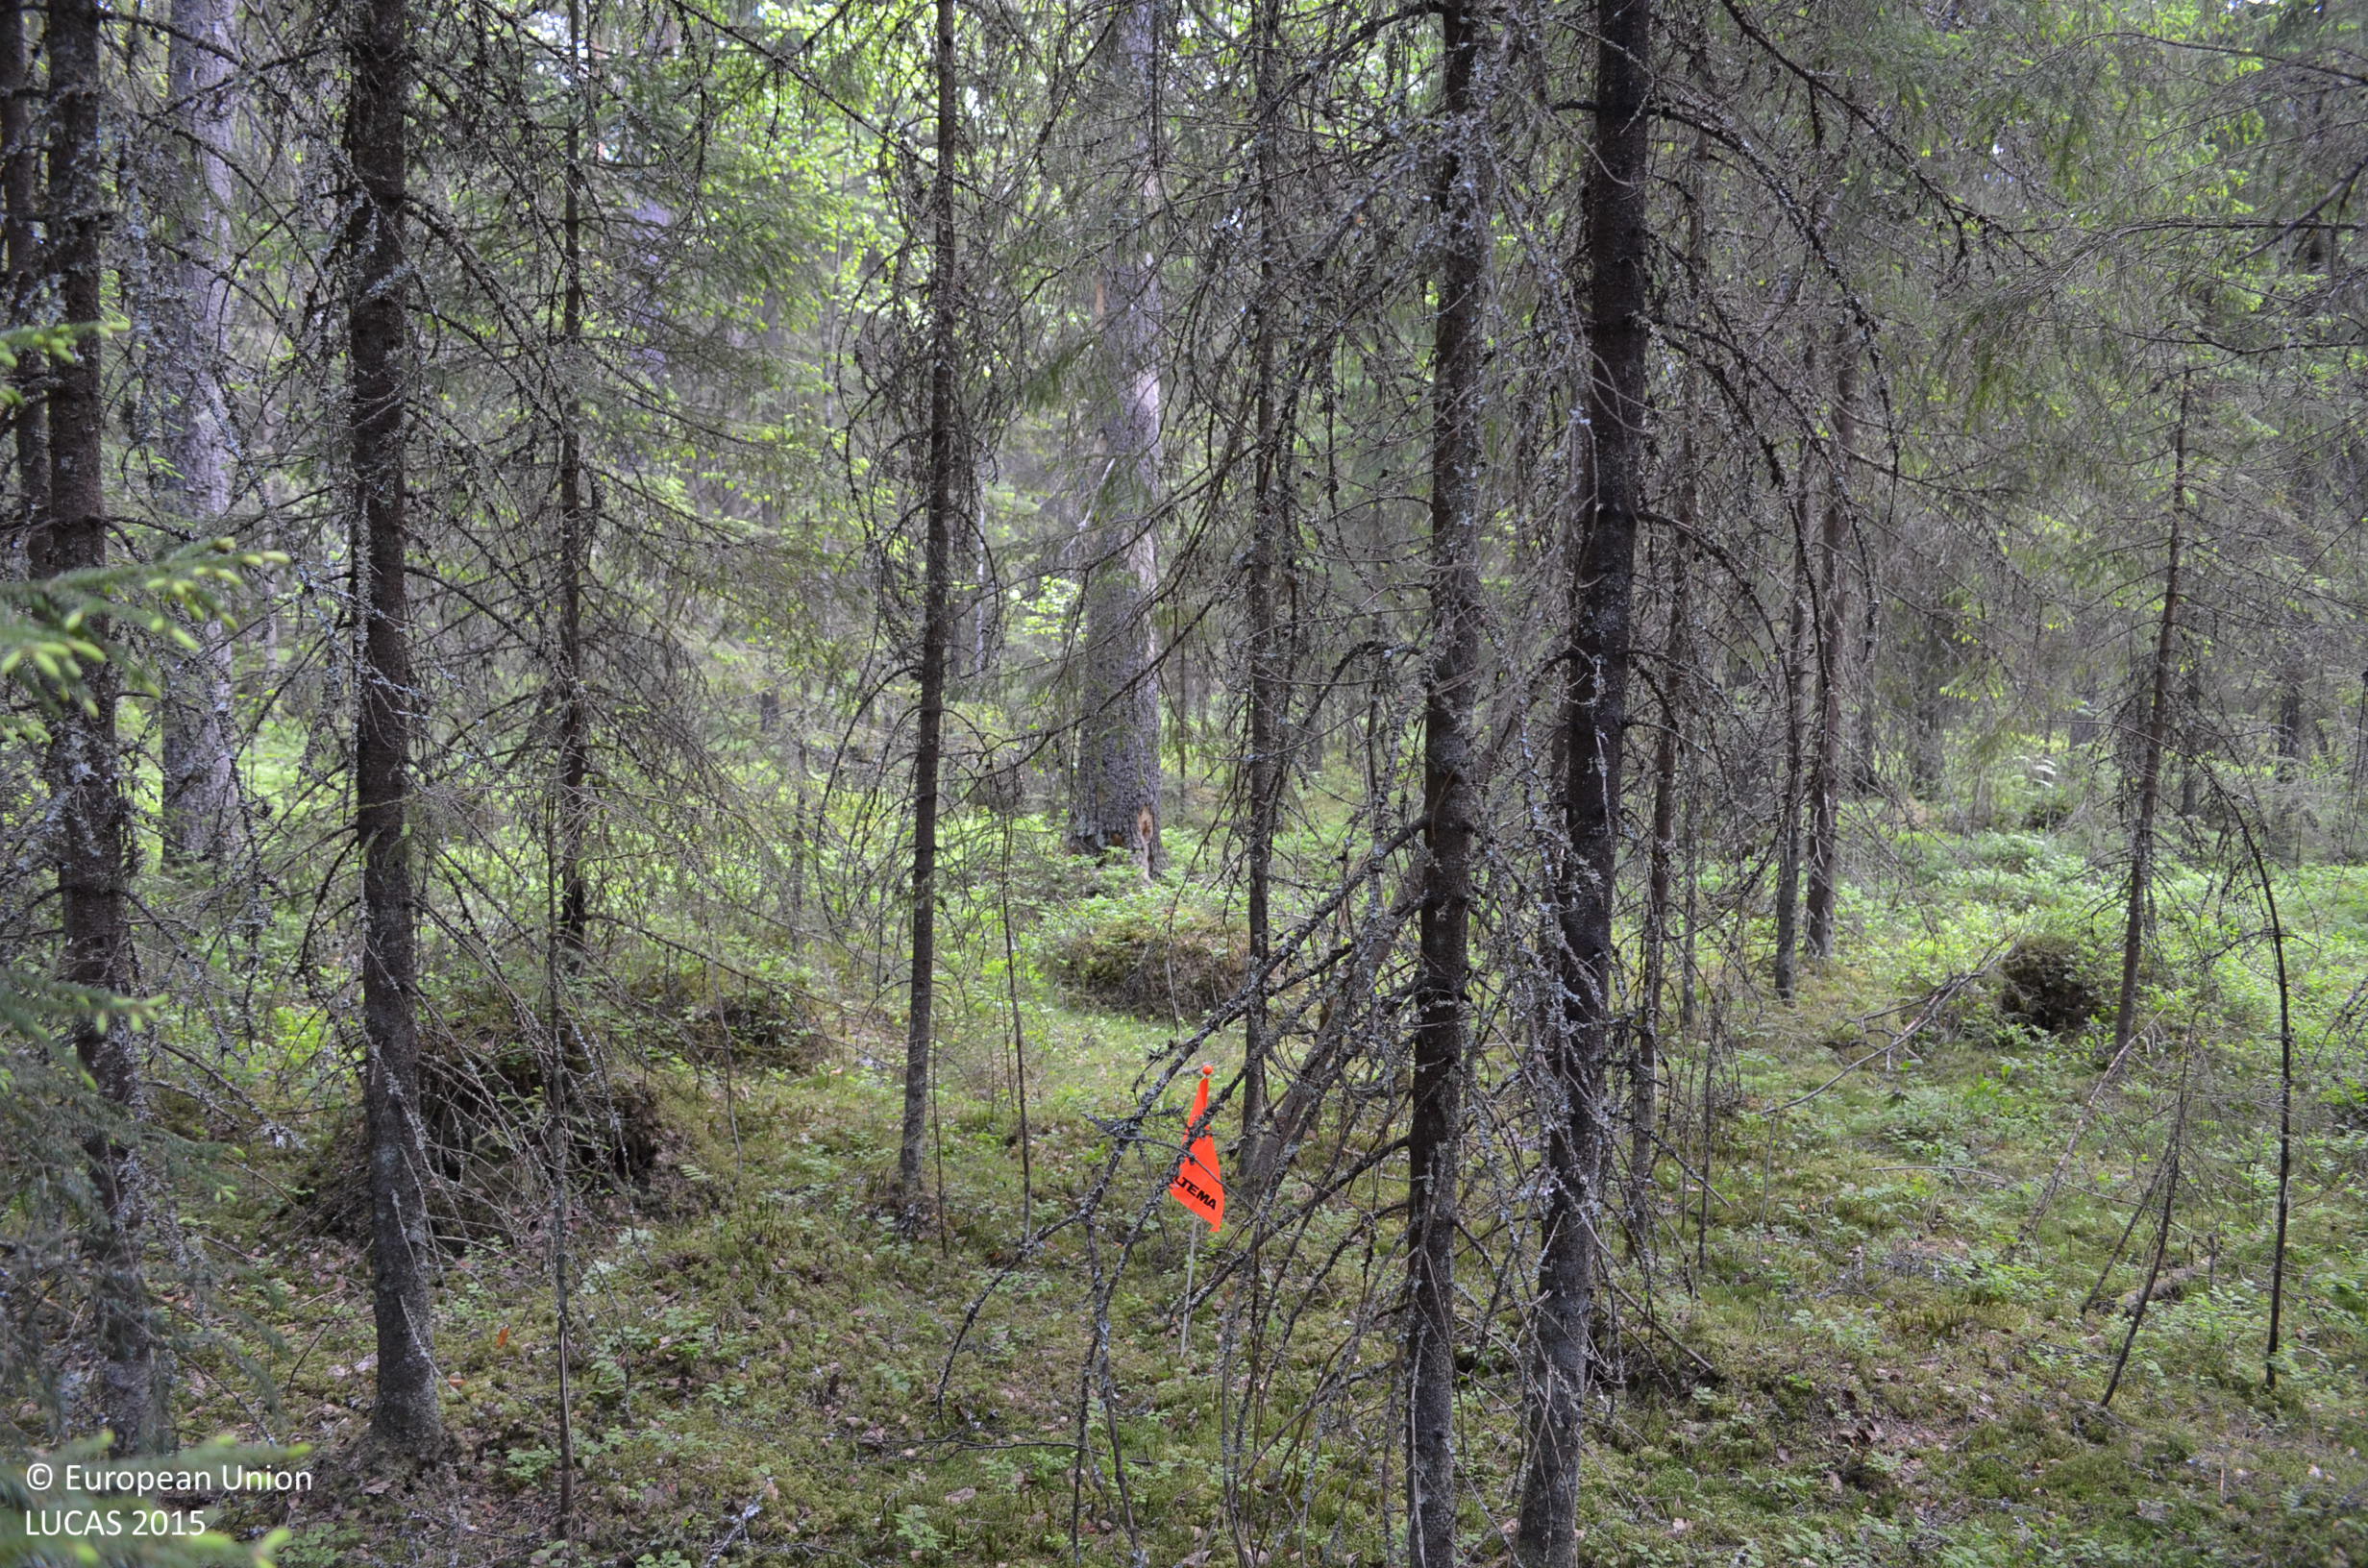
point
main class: Woodland
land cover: Spruce dominated coniferous woodland
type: boreal forest
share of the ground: > 75 %
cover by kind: coniferous forest trees 75 %, shrubs 20 %, broadleaved forest trees 5 %
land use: Semi-natural and natural areas not in use
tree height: > 5 m
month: June
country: FI
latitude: 61.9338
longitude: 23.4305
